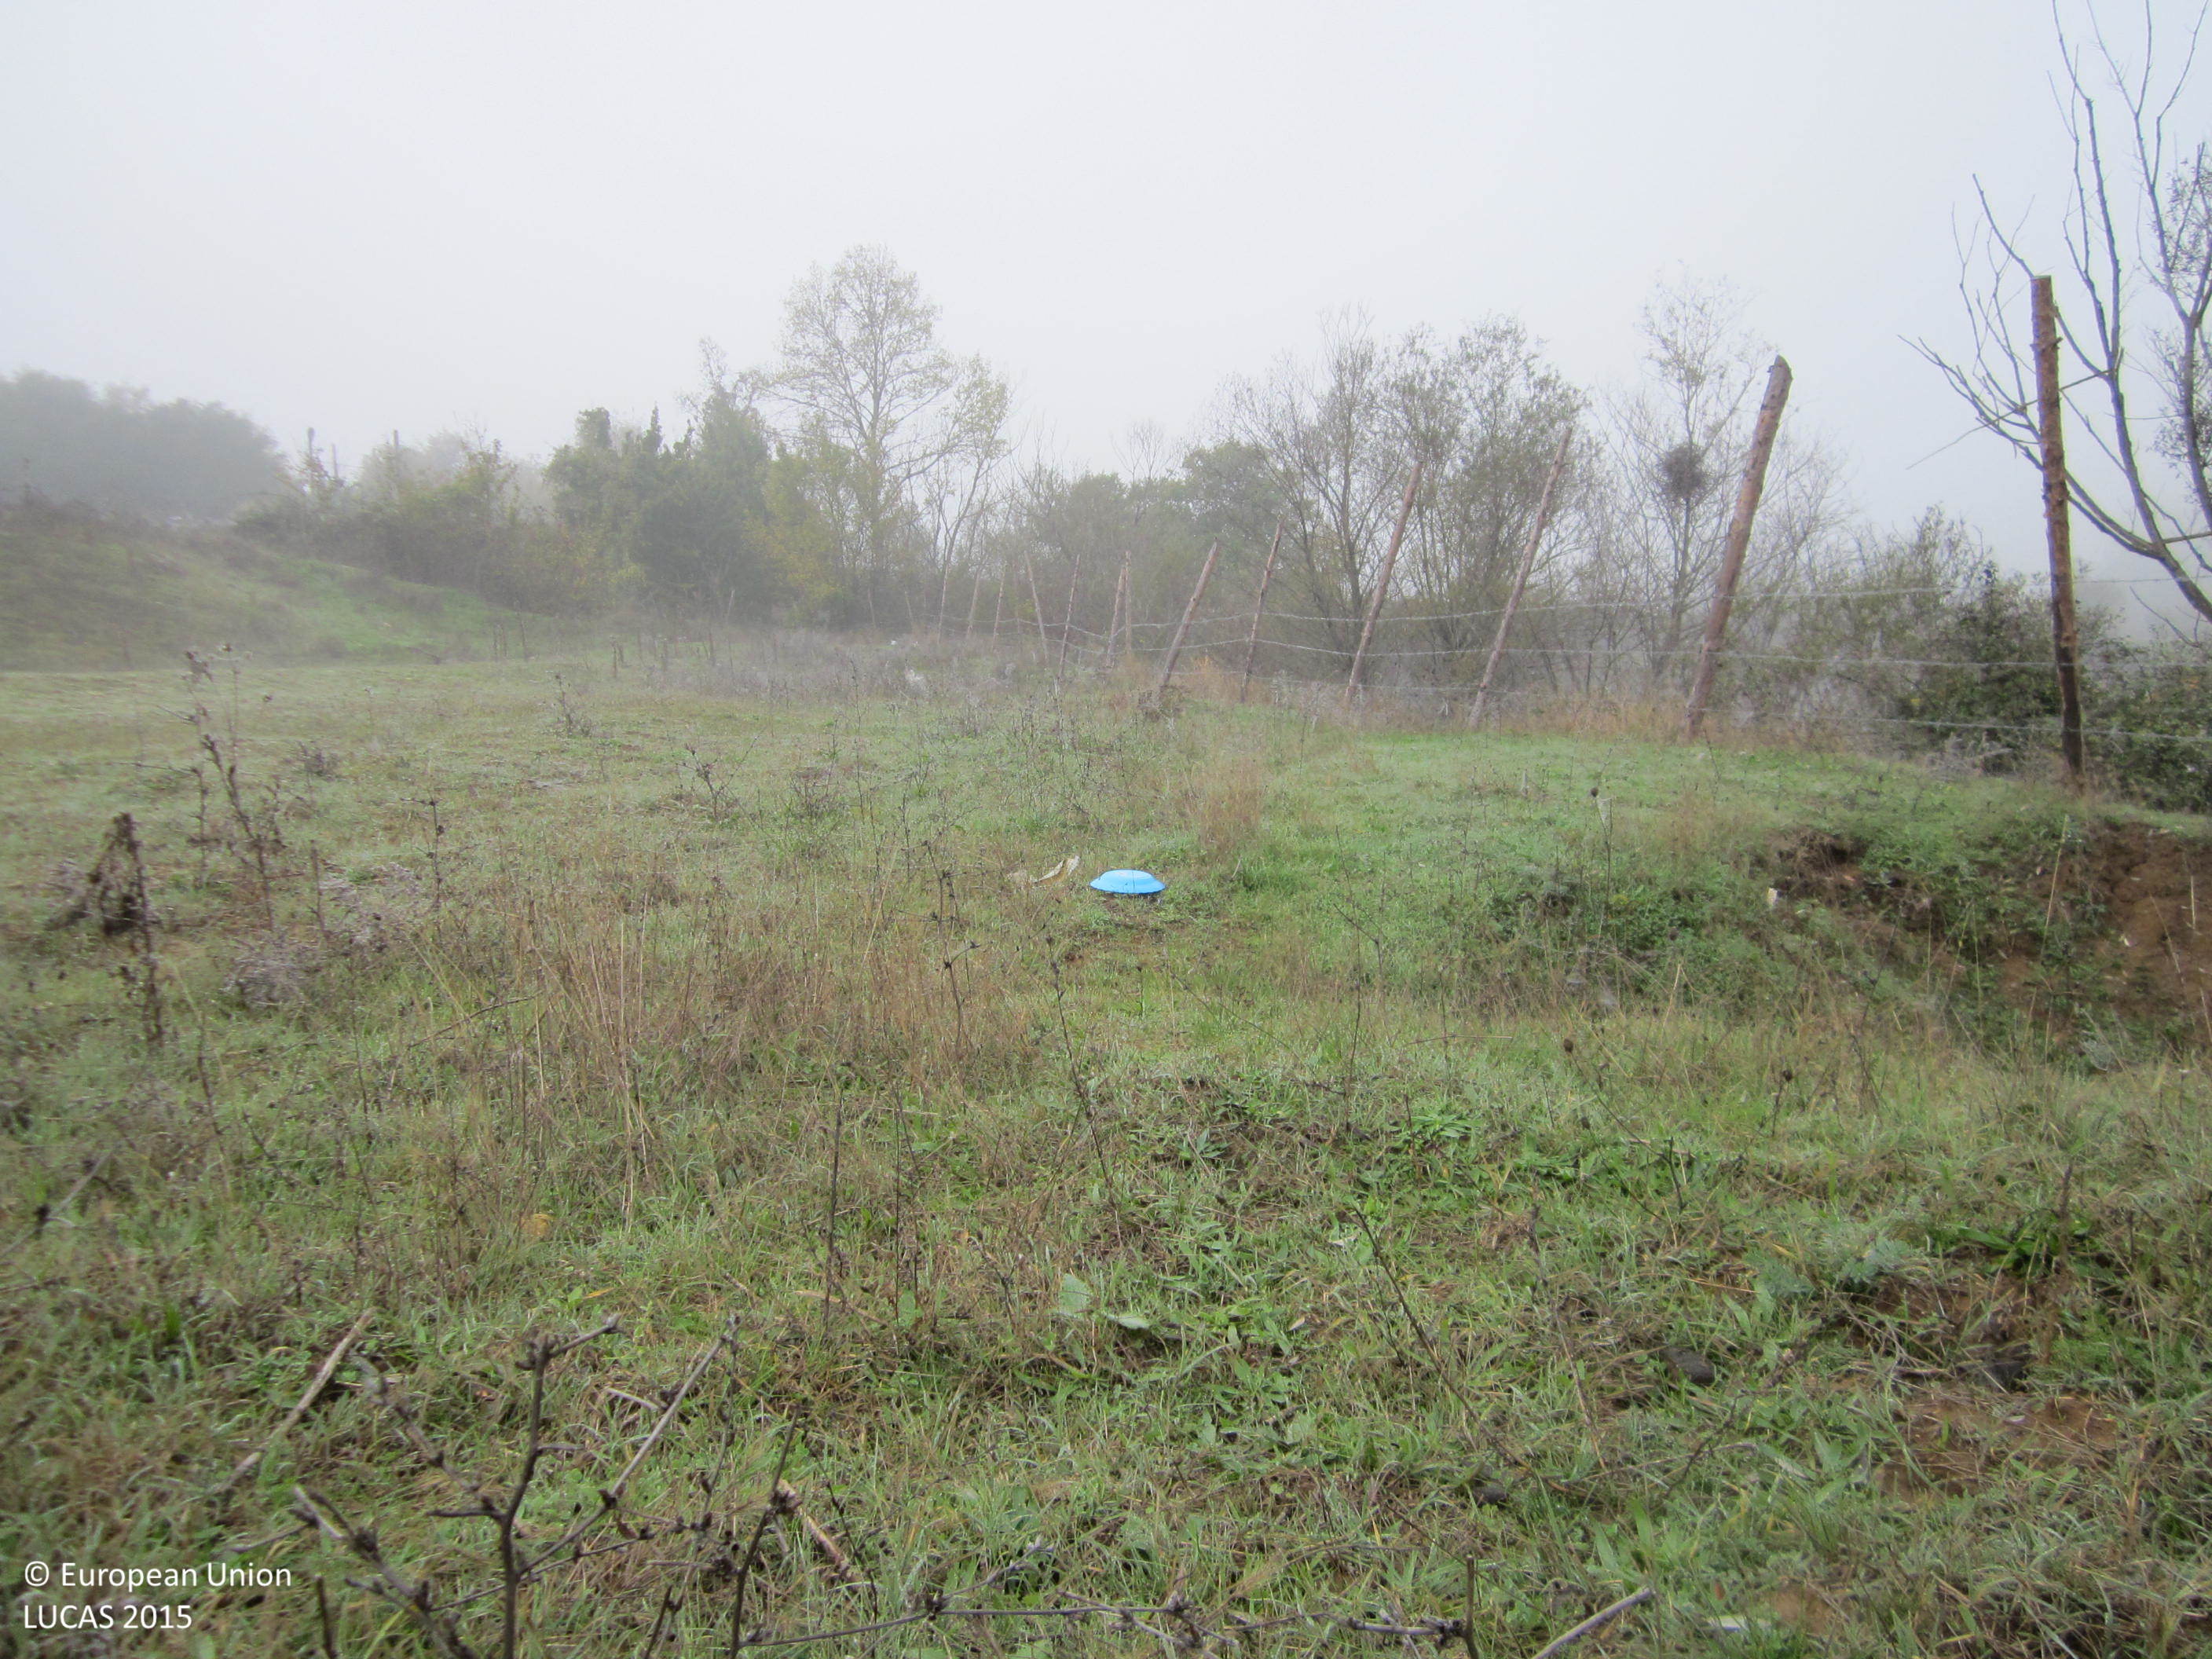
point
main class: Grassland
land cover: Grassland without tree/shrub cover
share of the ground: > 75 %
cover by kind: herbaceous plants 100 %
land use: Agriculture (excluding fallow land and kitchen gardens)
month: October
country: BG
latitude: 41.4675
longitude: 25.6373
